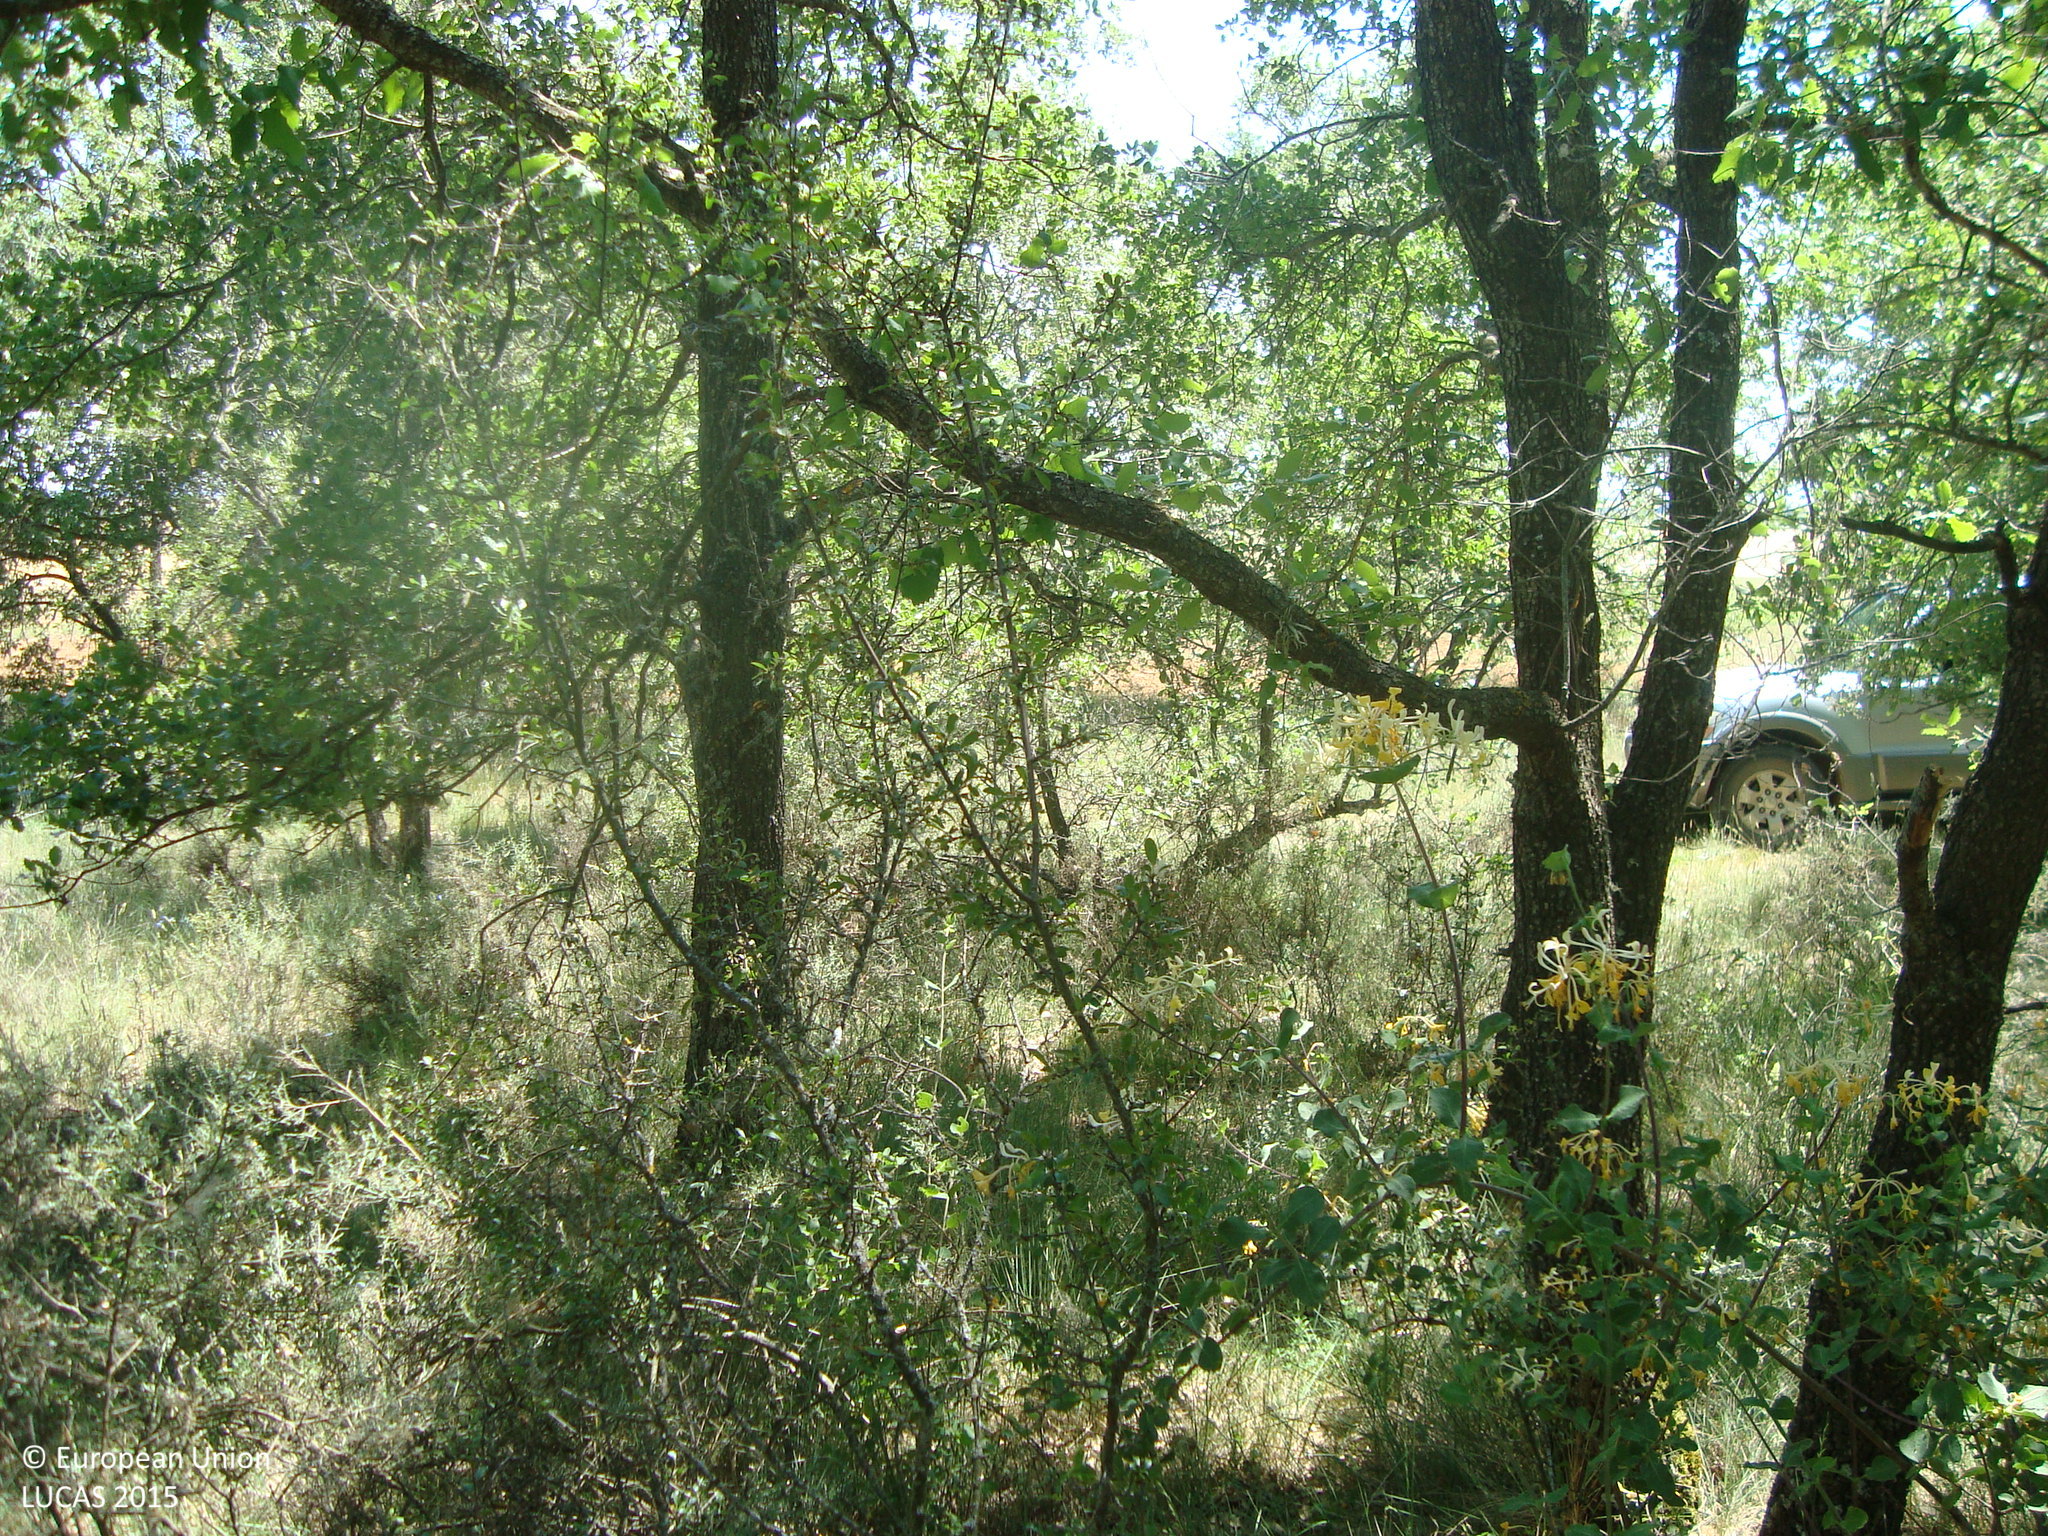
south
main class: Woodland
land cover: Broadleaved woodland
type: thermophilous deciduous forest
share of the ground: 50 - 75 %
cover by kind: broadleaved forest trees 60 %, herbaceous plants 20 %, shrubs 10 %, unconsolidated bare surface 10 %
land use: Forestry
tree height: > 5 m
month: June
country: ES
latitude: 41.8302
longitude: -3.5504
